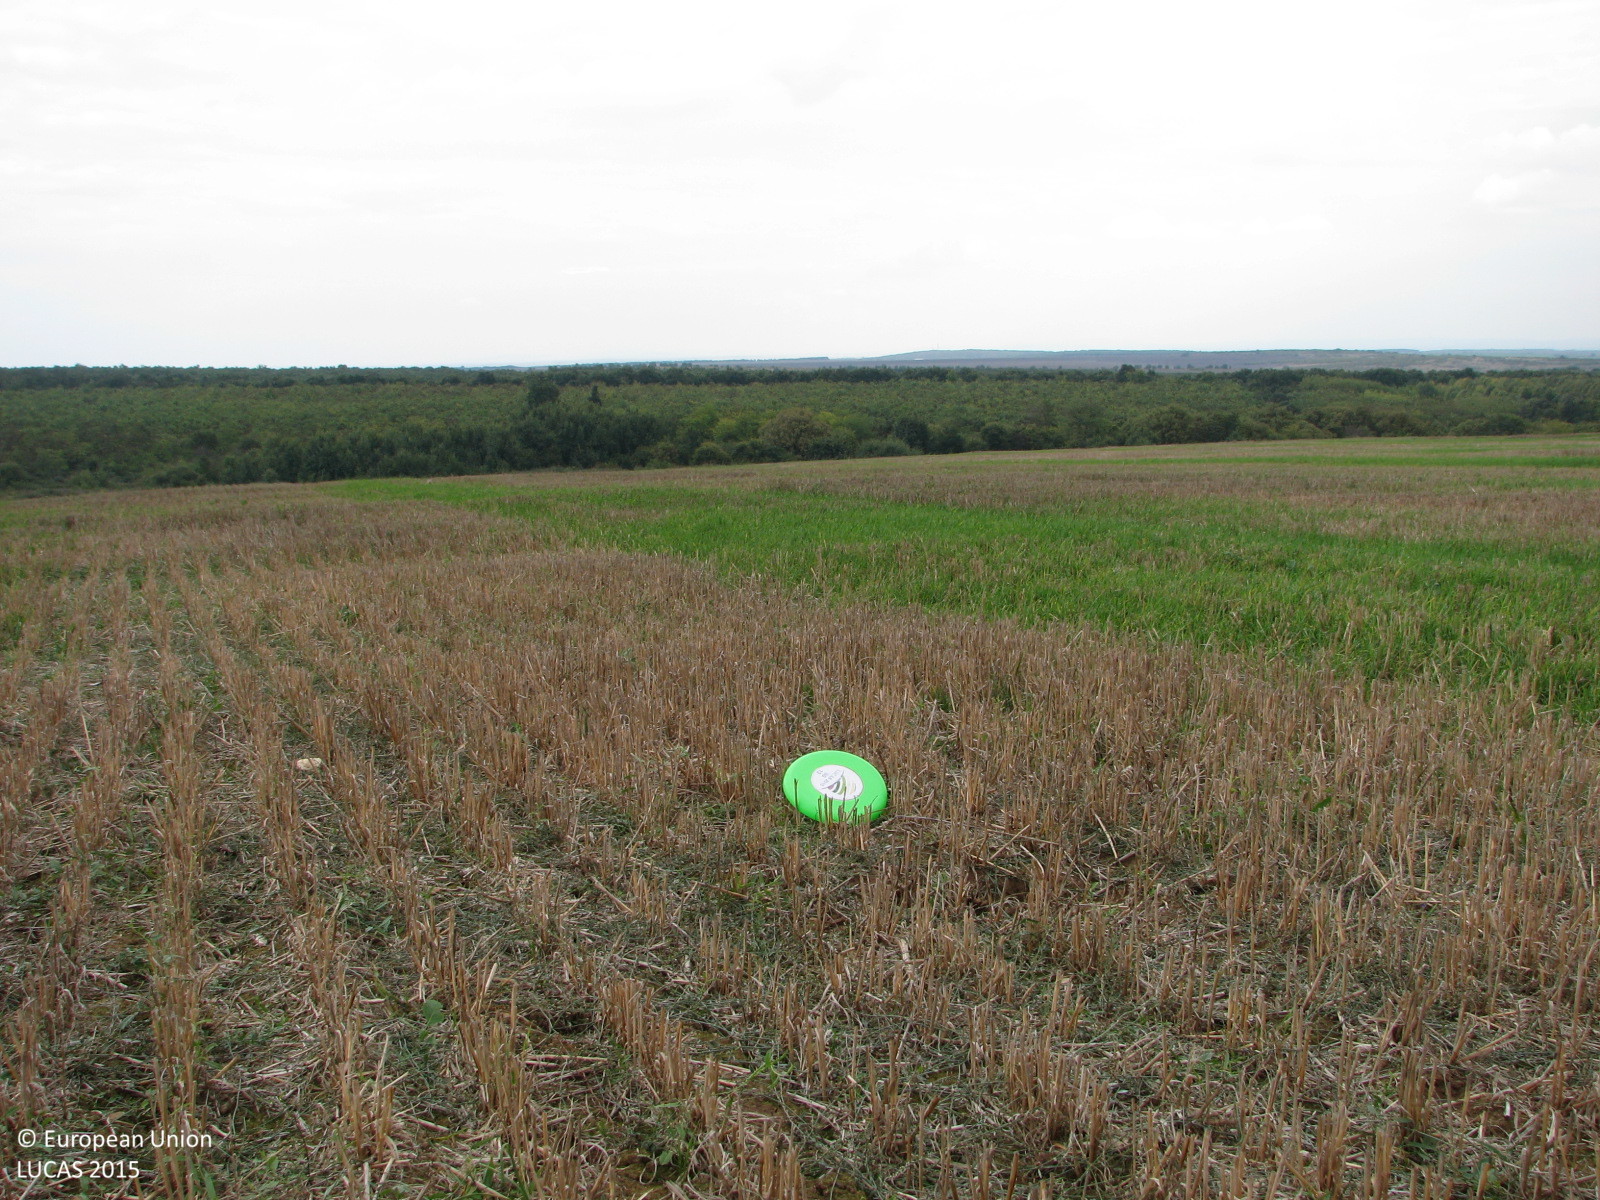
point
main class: Cropland
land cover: Common wheat
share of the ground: > 75 %
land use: Agriculture (excluding fallow land and kitchen gardens)
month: October
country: BG
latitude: 42.2739
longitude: 26.4446
